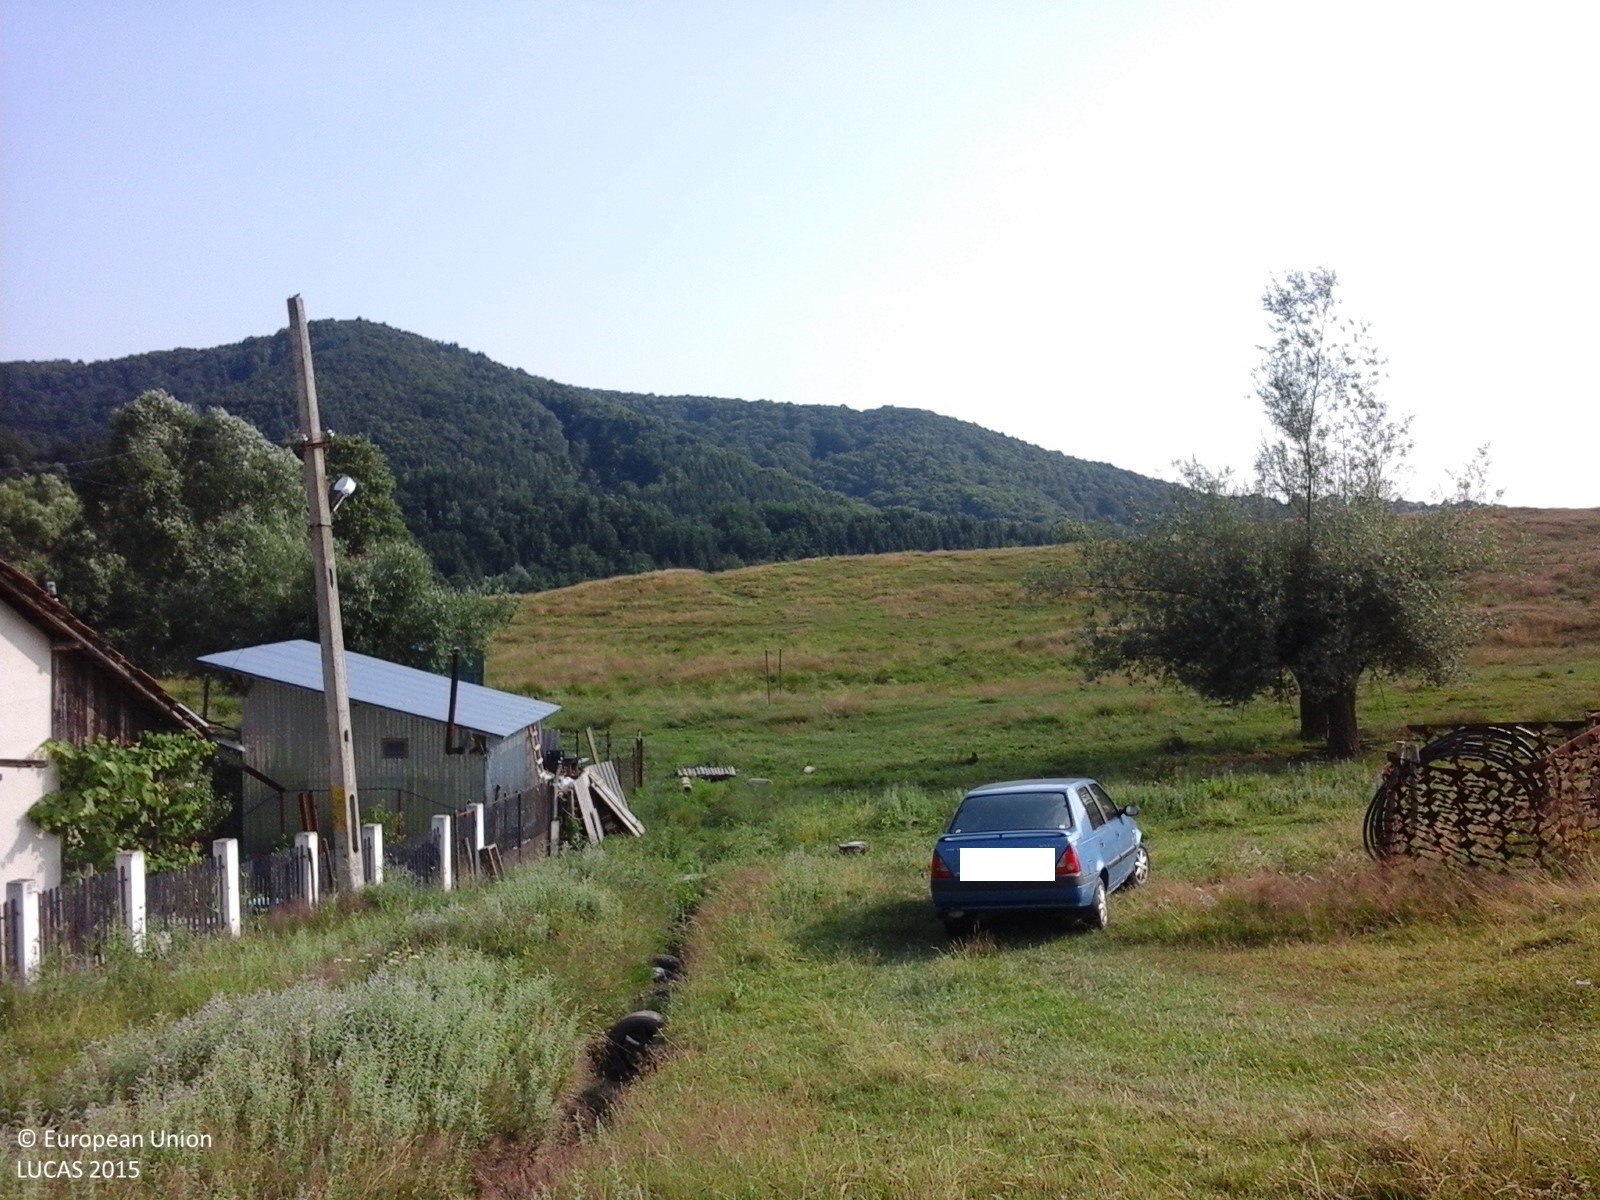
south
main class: Cropland
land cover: Other fruit trees and berries
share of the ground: > 75 %
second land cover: Grassland without tree/shrub cover
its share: 10 - 25 %
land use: Agriculture (excluding fallow land and kitchen gardens)
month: July
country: RO
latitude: 45.1642
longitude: 24.6986
